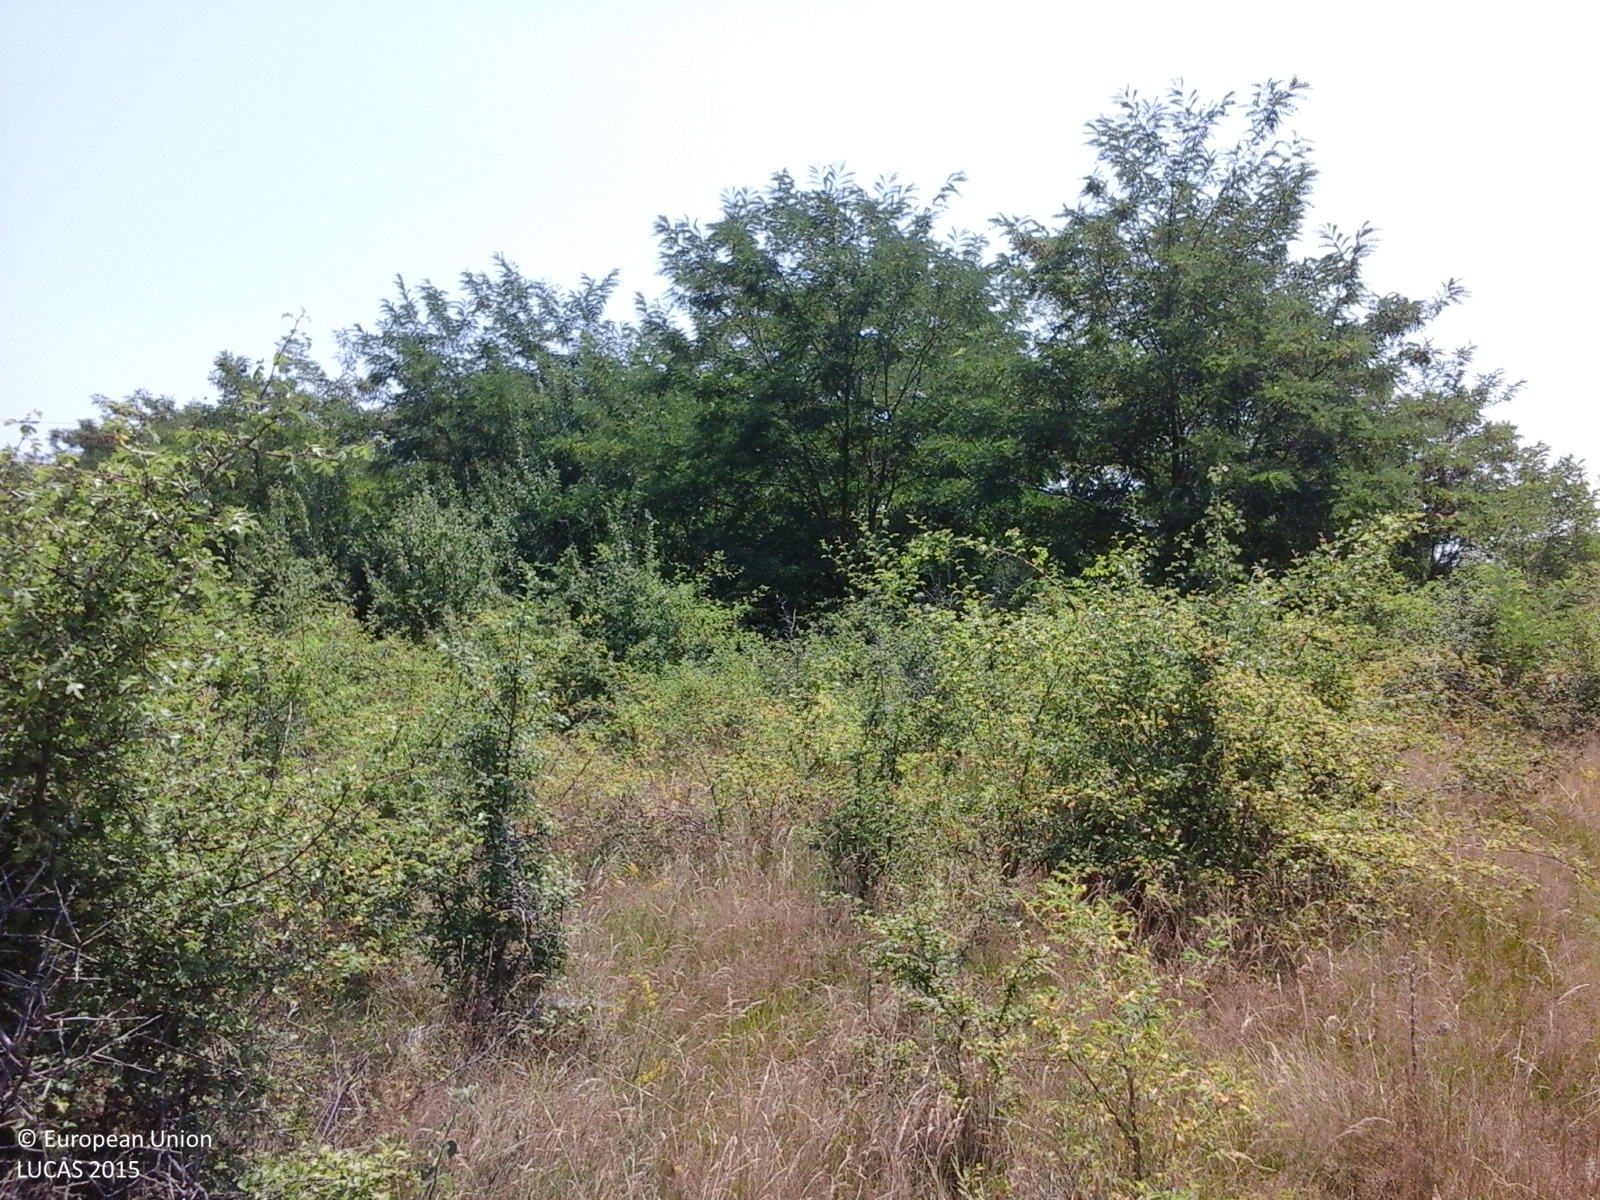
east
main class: Shrubland
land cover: Shrubland with sparse tree cover
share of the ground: > 75 %
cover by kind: shrubs 80 %, herbaceous plants 15 %, broadleaved forest trees 5 %
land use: Semi-natural and natural areas not in use
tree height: < 5 m
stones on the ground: < 10 %
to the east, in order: Shrubland with sparse tree cover; Broadleaved woodland; Tracks; Broadleaved woodland
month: July
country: RO
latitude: 45.0197
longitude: 24.6857
